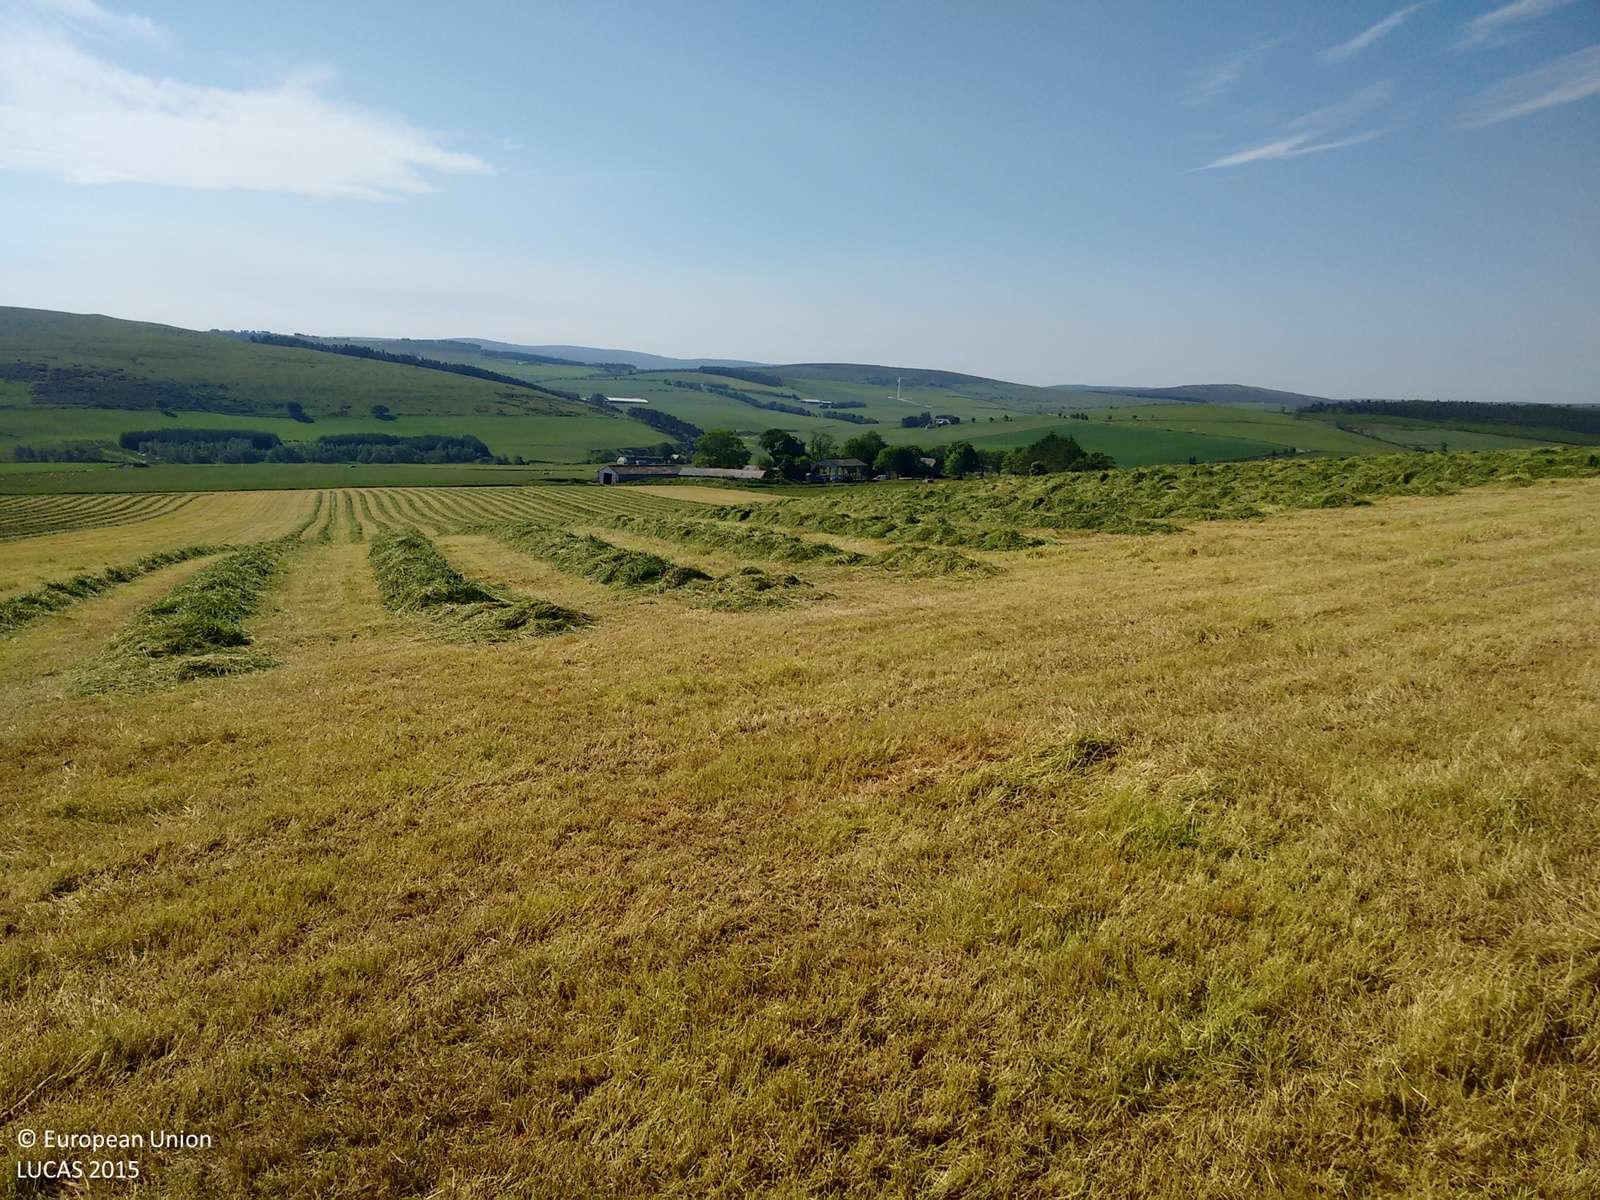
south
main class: Cropland
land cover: Temporary grasslands
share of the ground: > 75 %
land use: Agriculture (excluding fallow land and kitchen gardens)
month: July
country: GB
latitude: 57.4941
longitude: -2.9916
